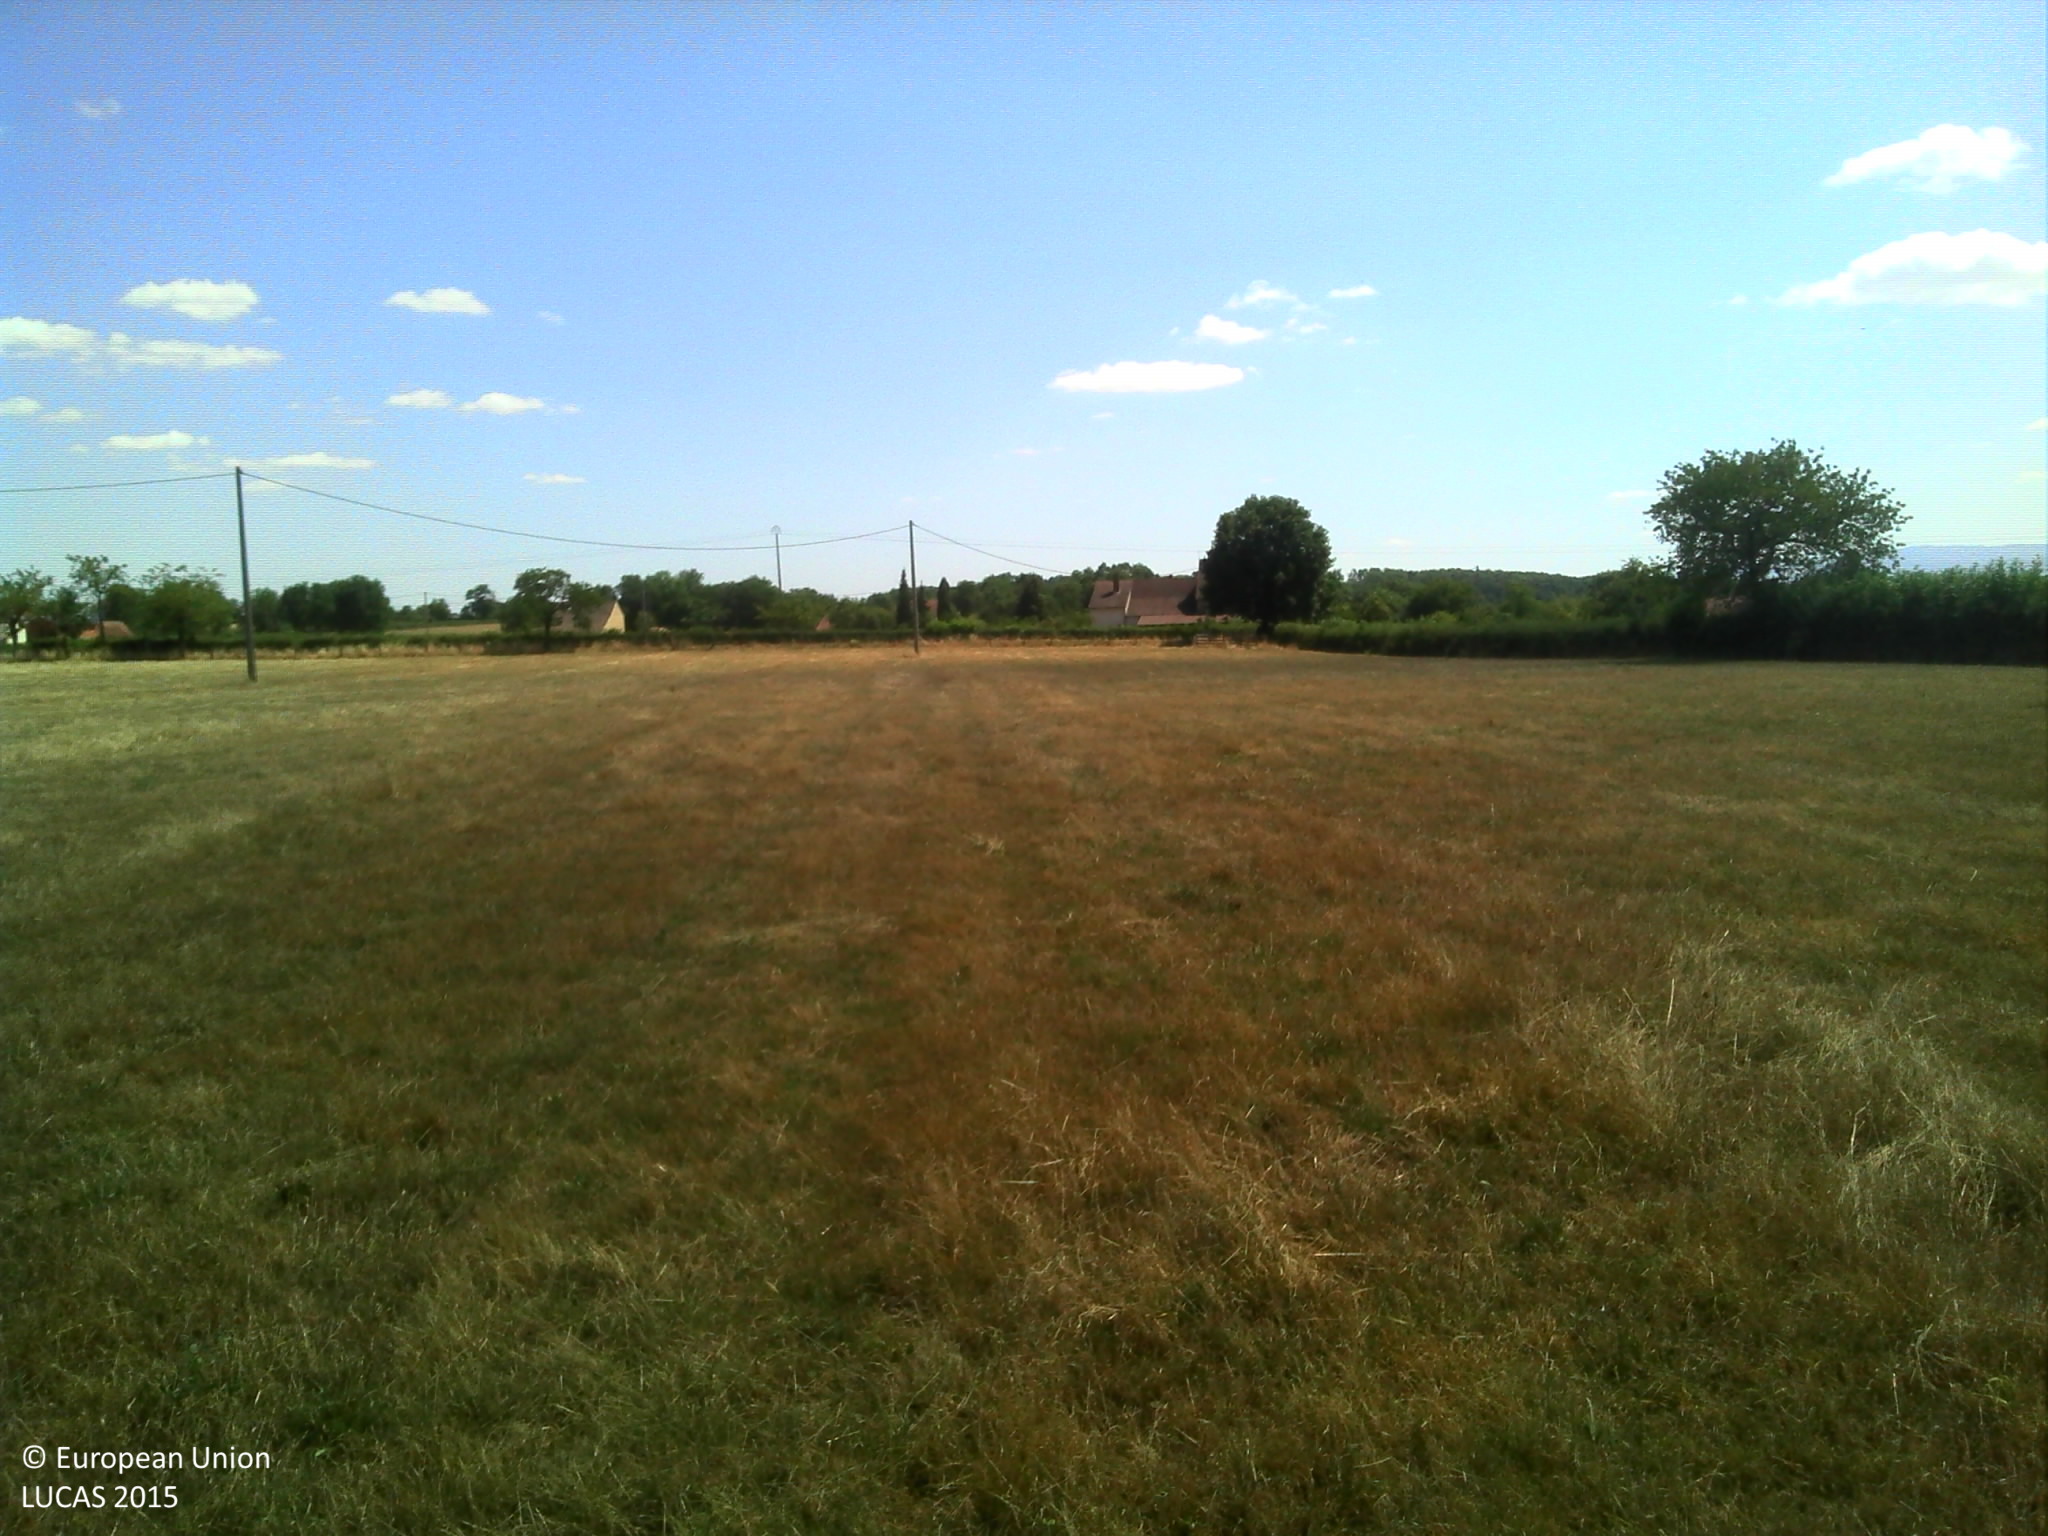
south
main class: Grassland
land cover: Grassland without tree/shrub cover
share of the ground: > 75 %
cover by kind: herbaceous plants 100 %
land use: Agriculture (excluding fallow land and kitchen gardens)
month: July
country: FR
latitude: 46.2770
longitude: 4.0703
